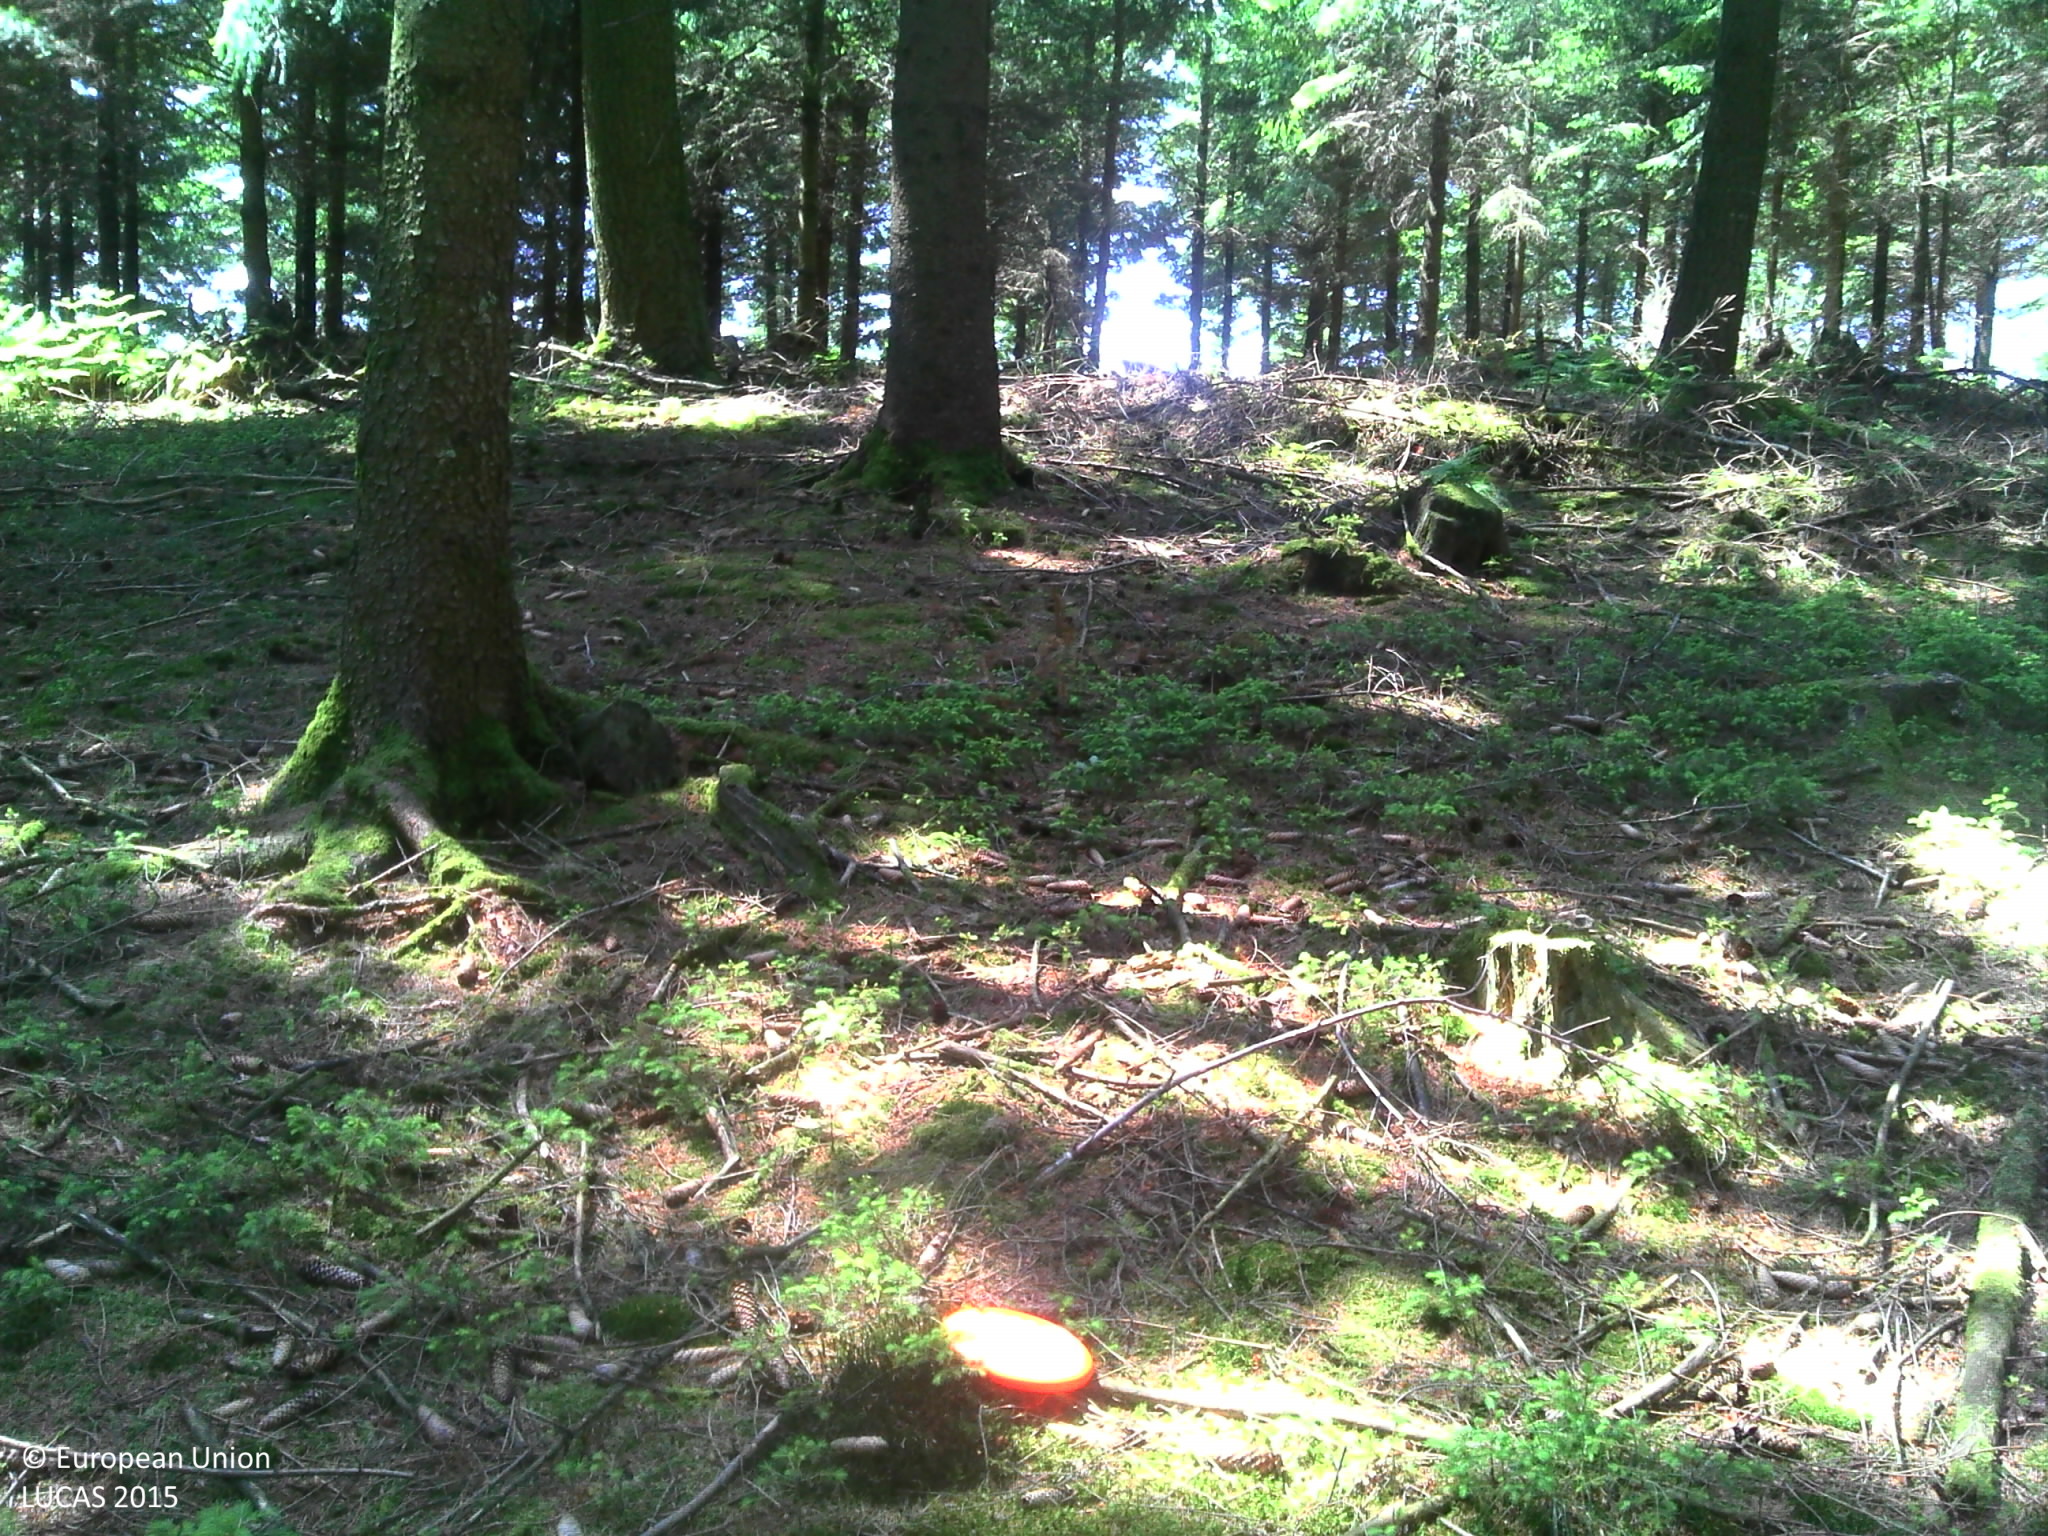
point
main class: Woodland
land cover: Spruce dominated coniferous woodland
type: alpine coniferous forest
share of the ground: > 75 %
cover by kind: coniferous forest trees 95 %, unconsolidated bare surface 5 %
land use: Forestry
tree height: > 5 m
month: June
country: BE
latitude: 49.9815
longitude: 4.5433
